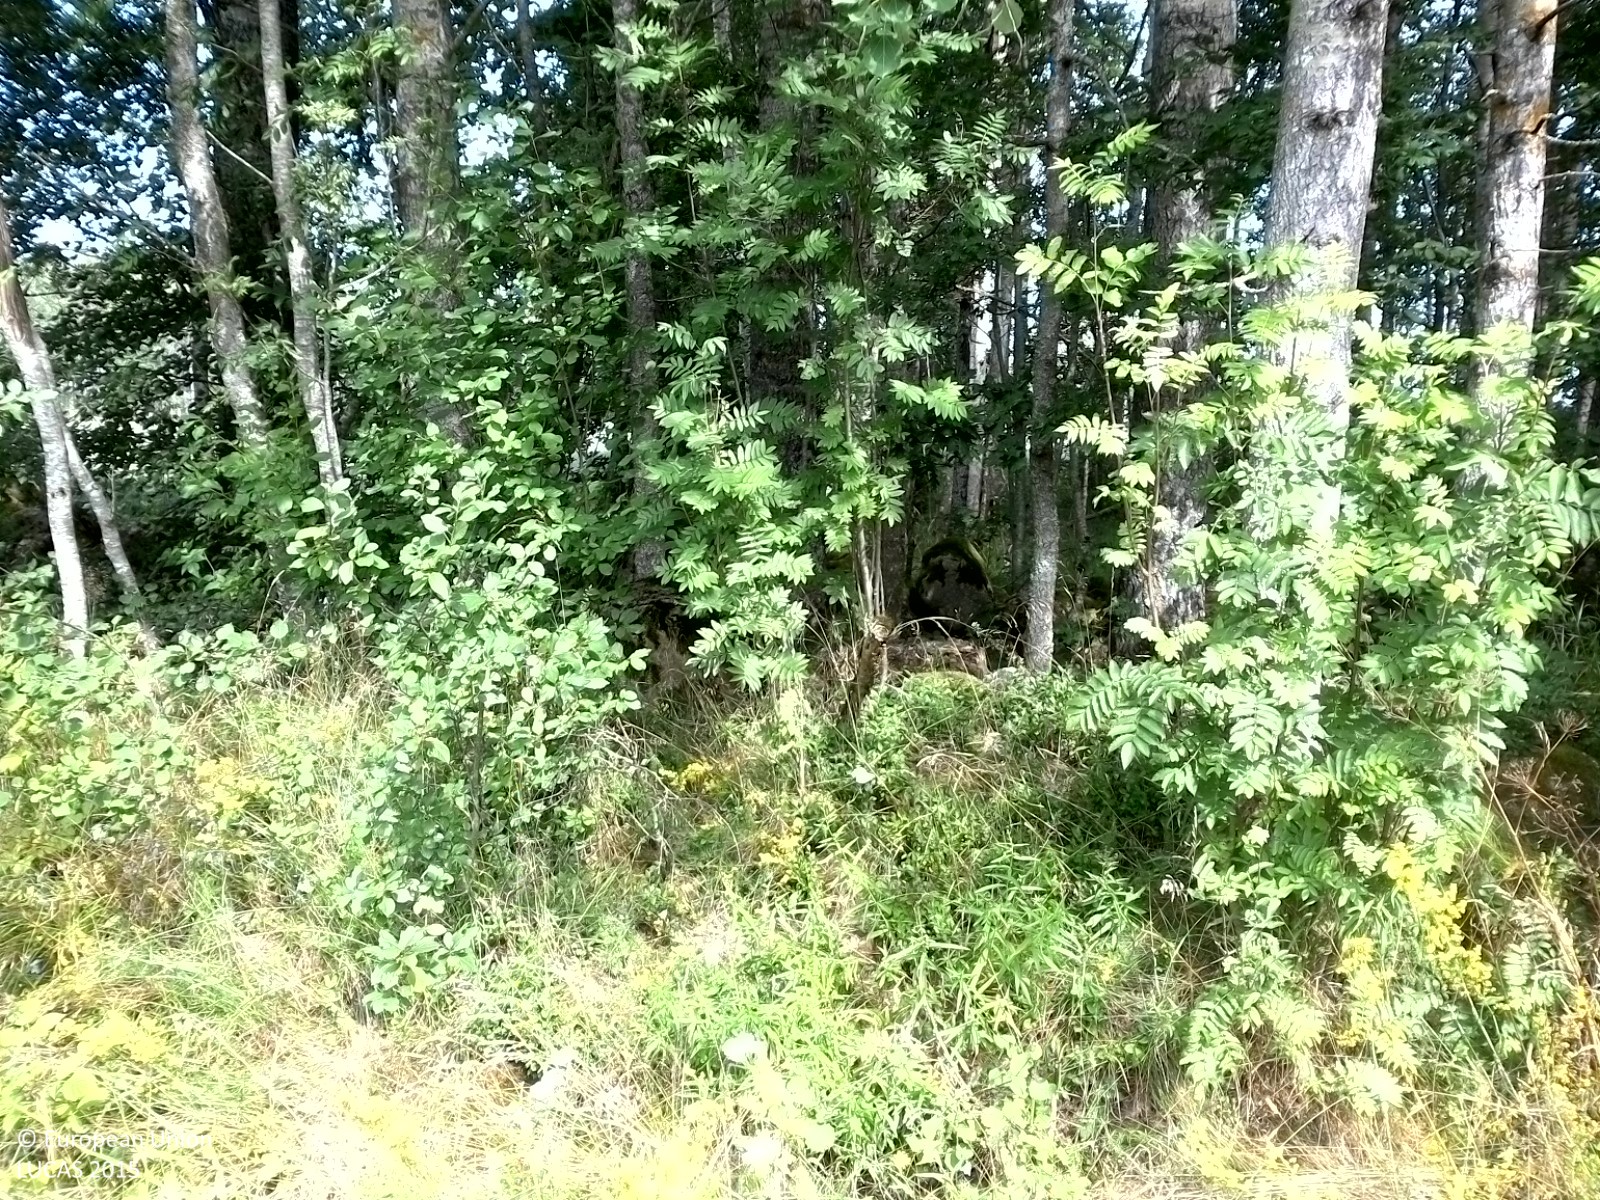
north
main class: Cropland
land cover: Temporary grasslands
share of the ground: > 75 %
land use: Agriculture (excluding fallow land and kitchen gardens)
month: August
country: SE
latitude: 59.0703
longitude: 14.8238
